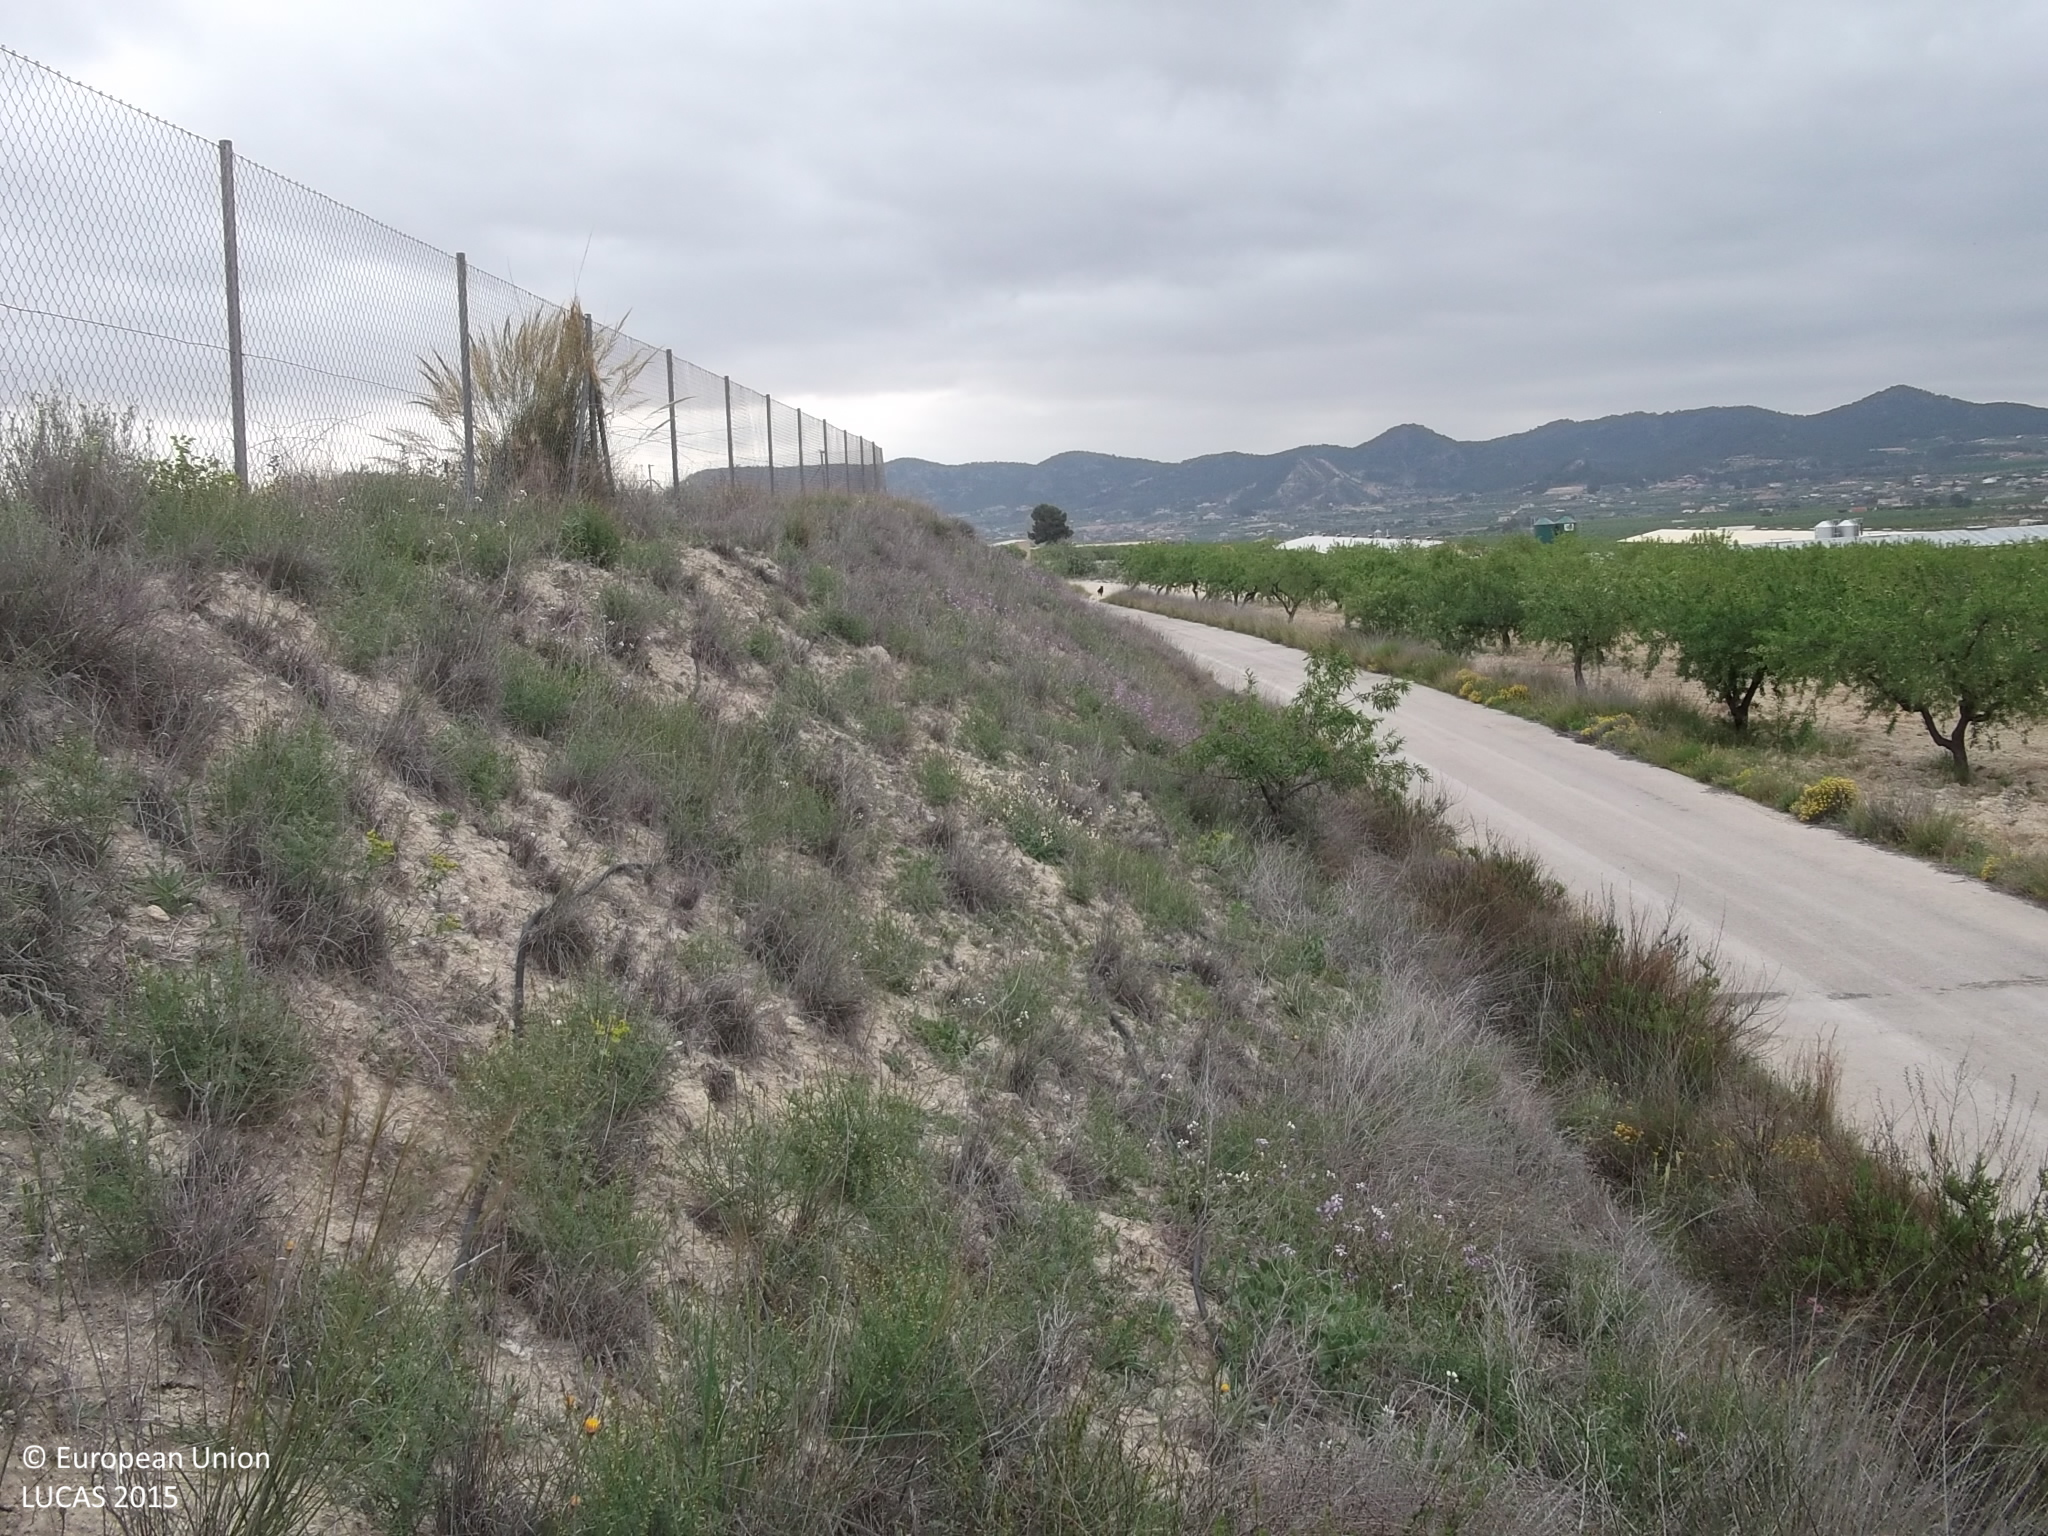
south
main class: Grassland
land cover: Grassland without tree/shrub cover
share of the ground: 10 - 25 %
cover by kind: consolidated bare surface 70 %, herbaceous plants 30 %
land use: Abandoned areas
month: April
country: ES
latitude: 37.9729
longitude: -1.5631
